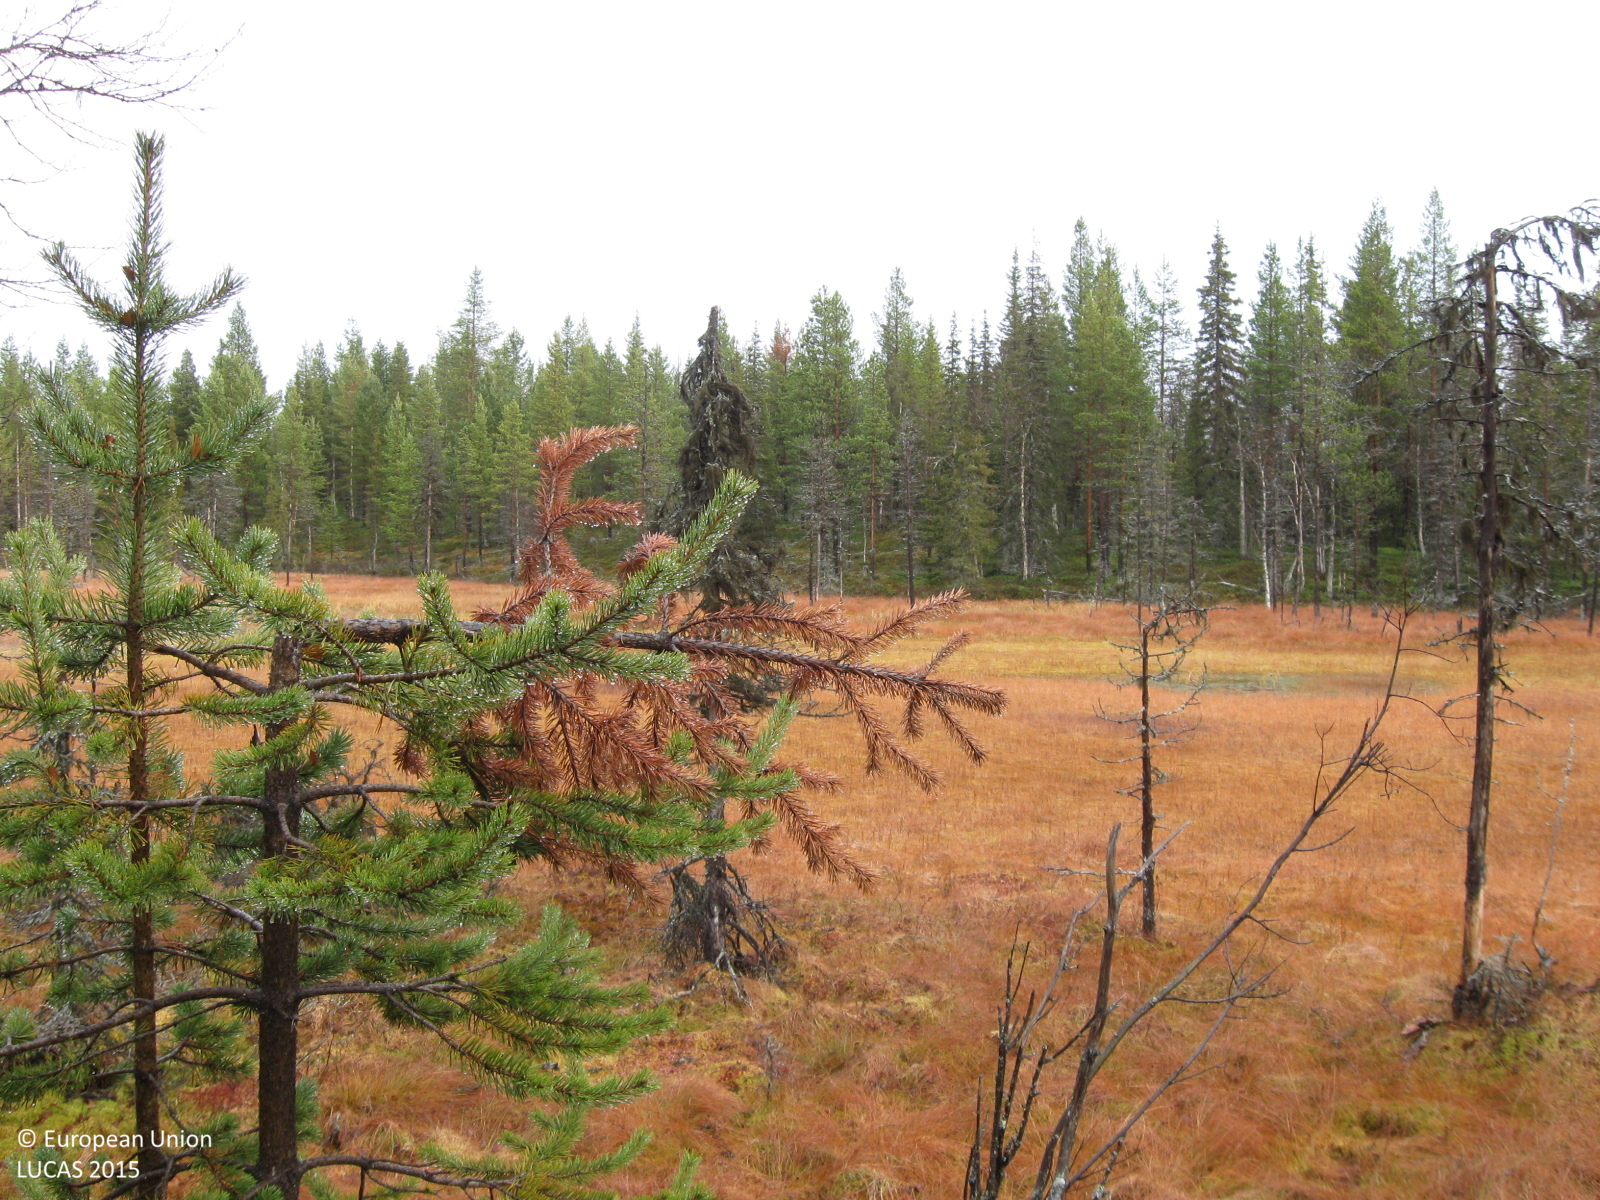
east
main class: Woodland
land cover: Pine dominated mixed woodland
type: boreal forest
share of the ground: 25 - 50 %
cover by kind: herbaceous plants 25 %, coniferous forest trees 20 %, broadleaved forest trees 20 %, shrubs 20 %, lichens and mosses 15 %
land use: Forestry
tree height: > 5 m
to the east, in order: Pine dominated mixed woodland; Peatbogs; Pine dominated mixed woodland; Peatbogs; Pine dominated mixed woodland; Peatbogs
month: October
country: SE
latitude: 66.8289
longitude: 21.0466
